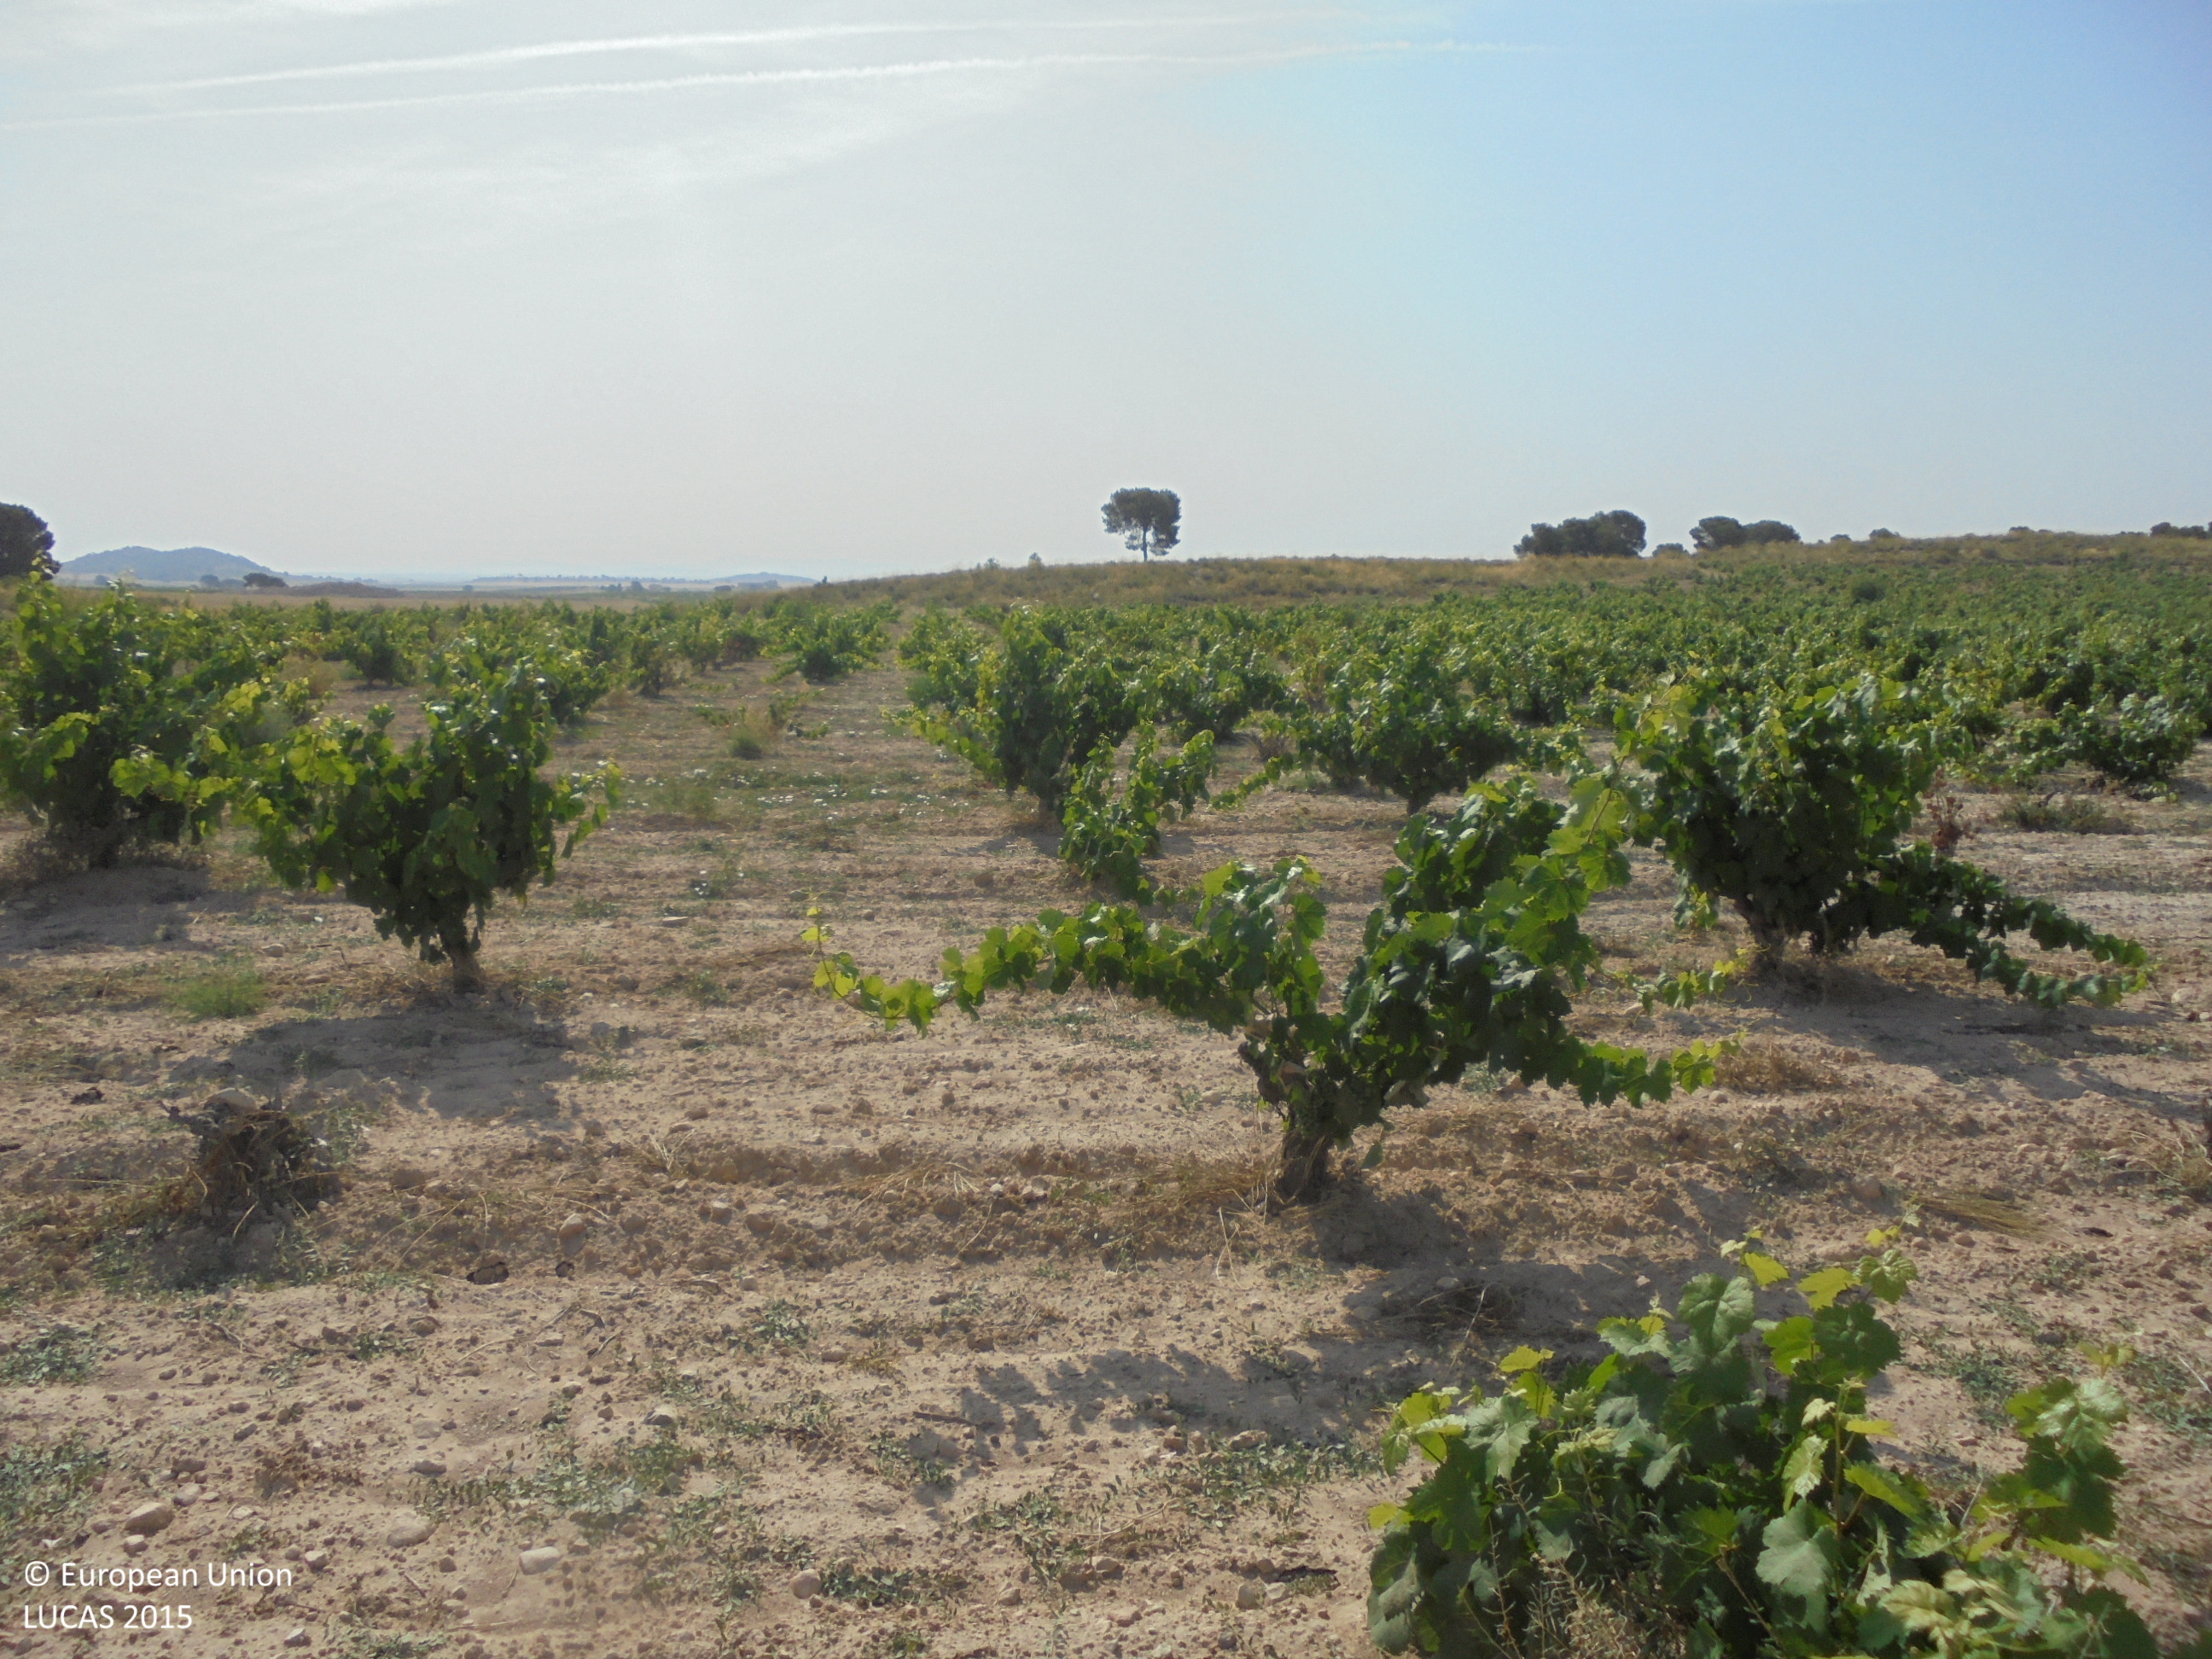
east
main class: Cropland
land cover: Vineyards
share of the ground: 10 - 25 %
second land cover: Spontaneously vegetated surfaces
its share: 10 - 25 %
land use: Agriculture (excluding fallow land and kitchen gardens)
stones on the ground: 10 - 25 %
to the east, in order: Vineyards; Spontaneously vegetated surfaces; Grassland without tree/shrub cover; Dry stone walls; Shrubland without tree cover; Oats
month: July
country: ES
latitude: 38.6079
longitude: -1.6038
